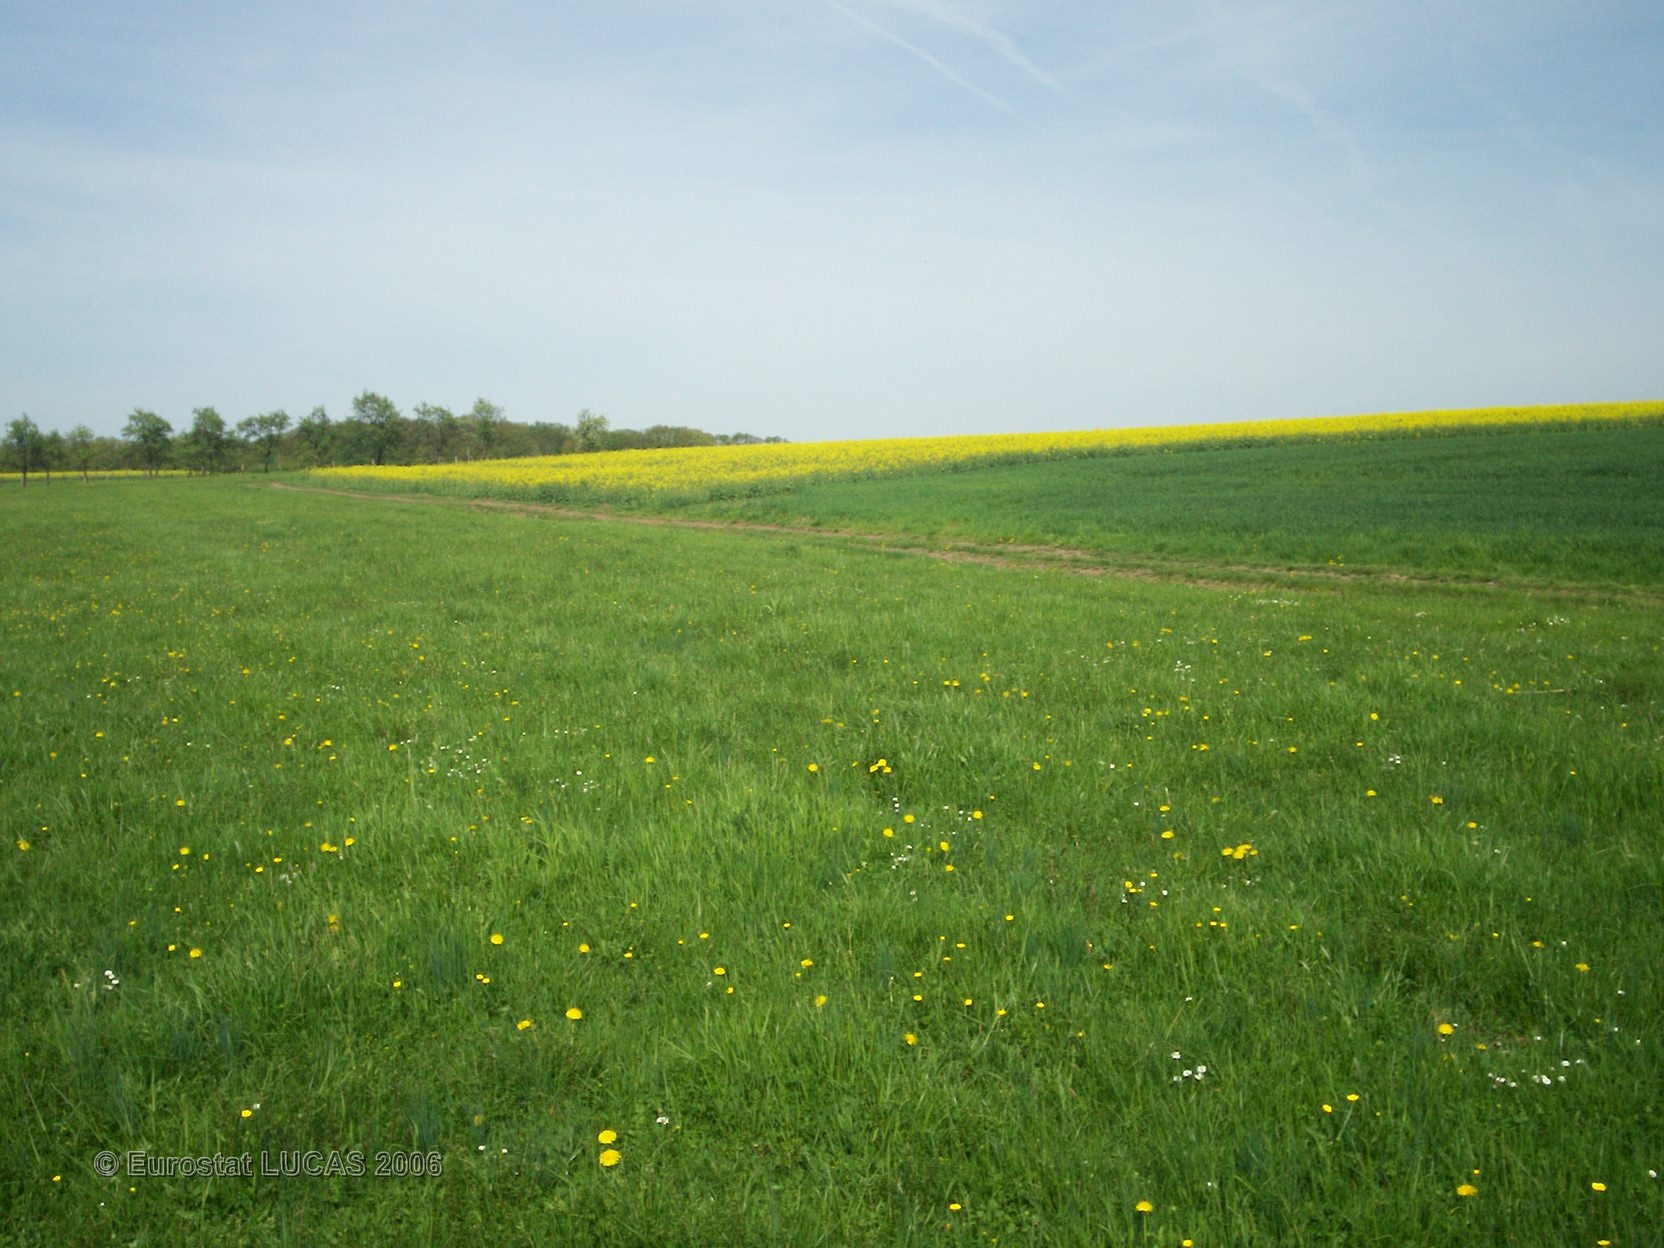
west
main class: Grassland
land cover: Grassland without tree/shrub cover
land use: Agriculture (excluding fallow land and kitchen gardens)
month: May
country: FR
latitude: 48.9565
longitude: 6.9823
